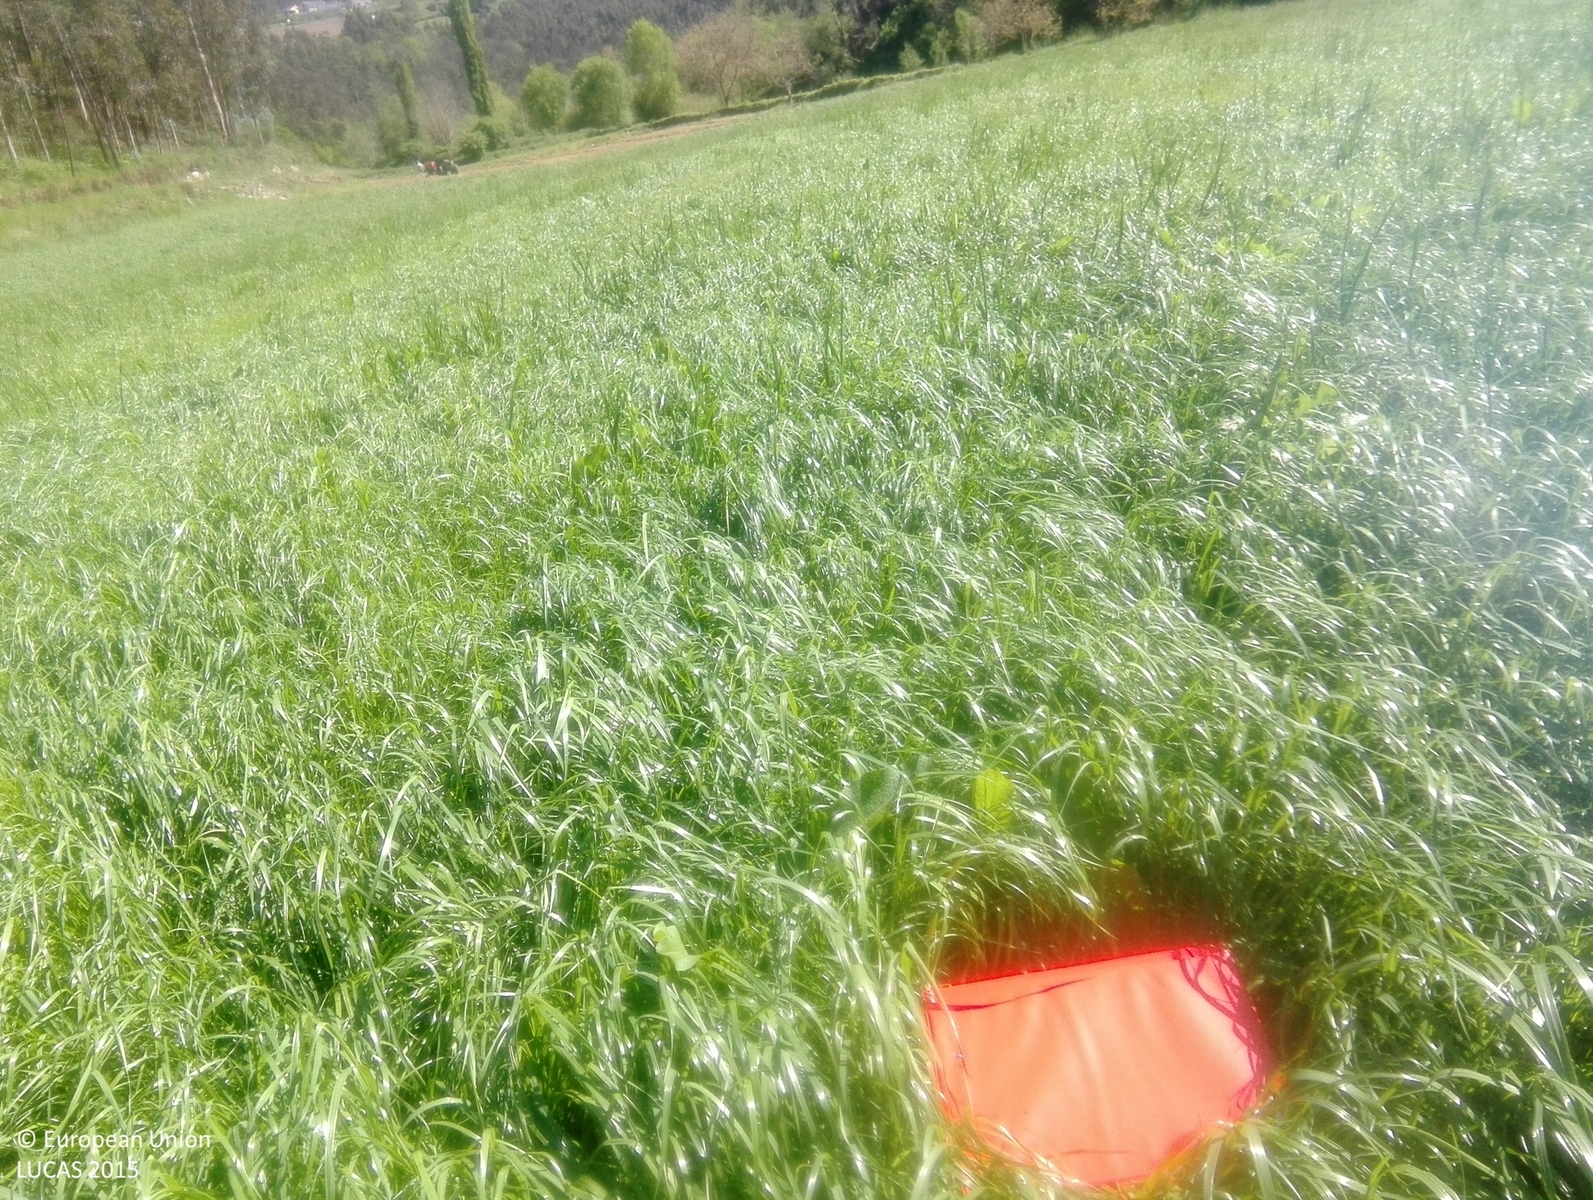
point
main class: Cropland
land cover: Temporary grasslands
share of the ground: > 75 %
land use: Agriculture (excluding fallow land and kitchen gardens)
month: April
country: ES
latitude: 43.4327
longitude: -7.1058
